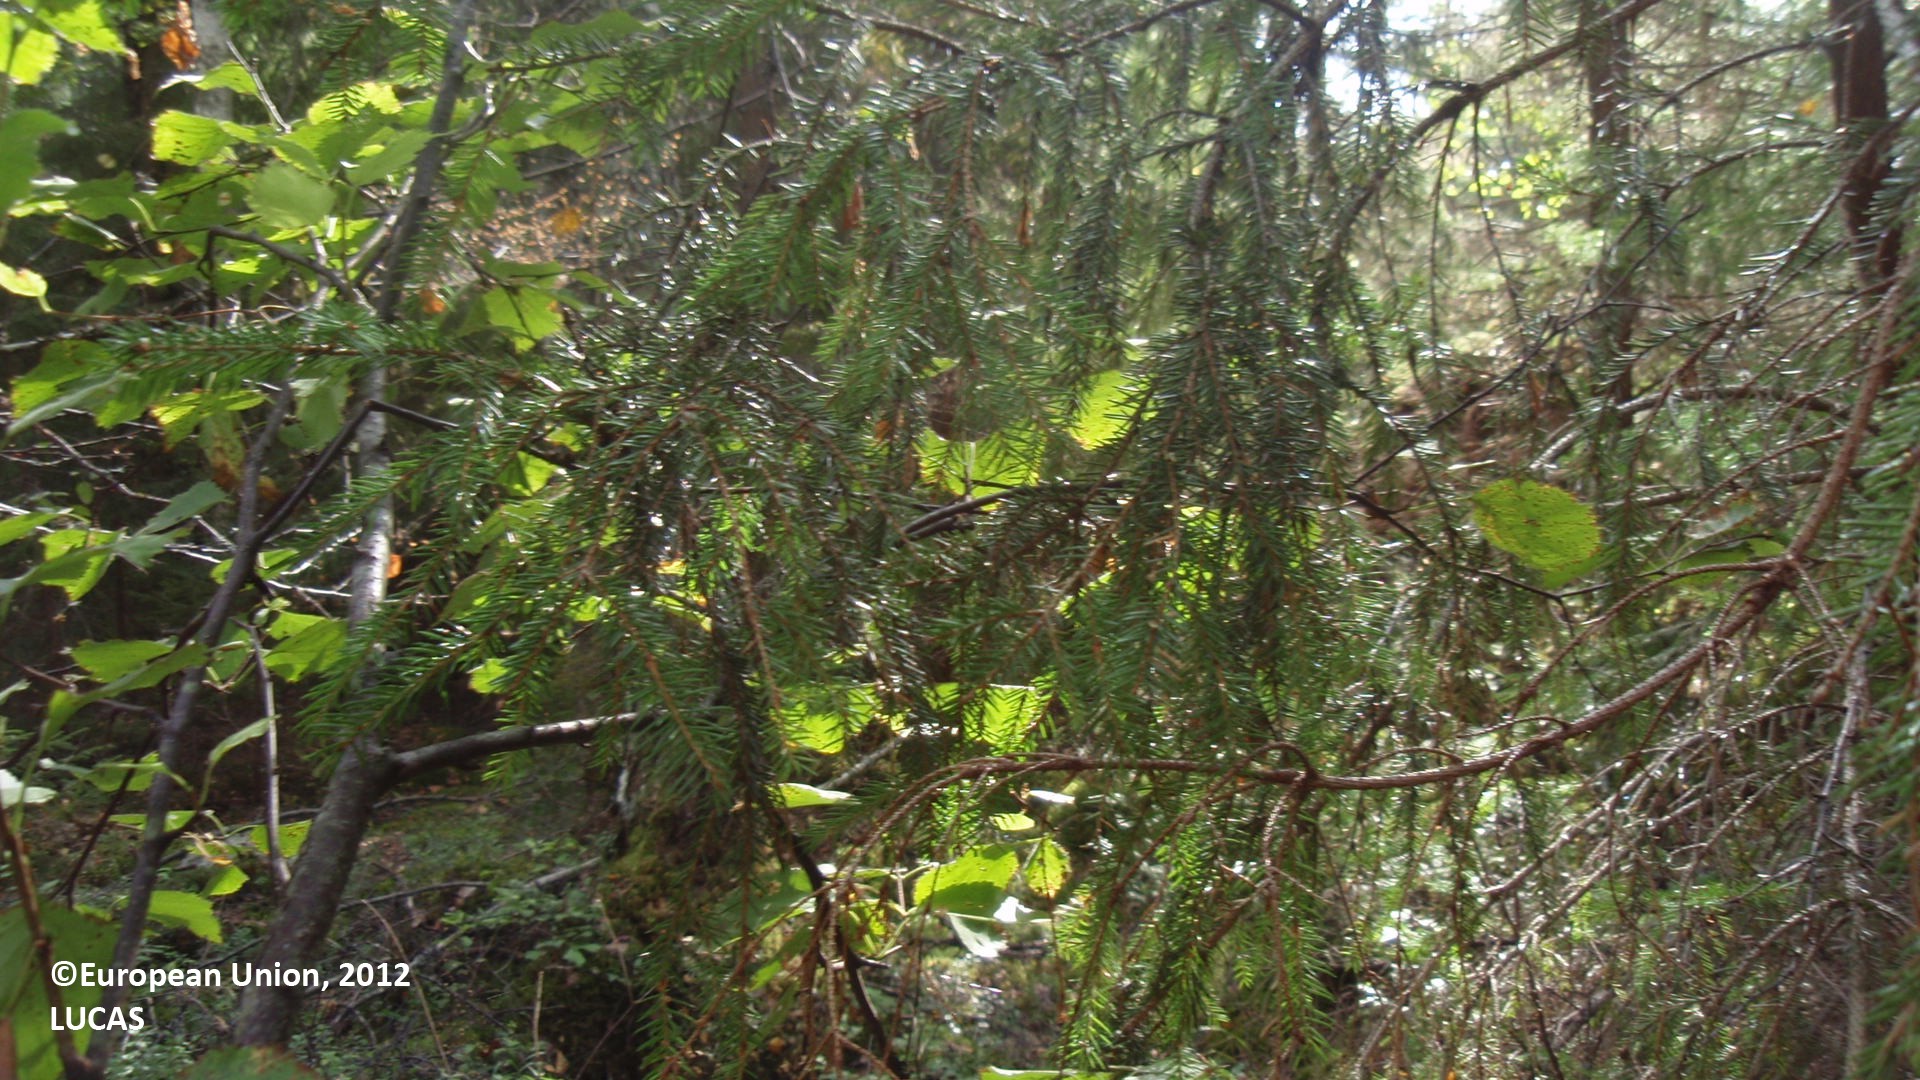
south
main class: Woodland
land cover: Spruce dominated mixed woodland
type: boreal forest
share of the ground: 50 - 75 %
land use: Forestry
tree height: > 5 m
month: August
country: FI
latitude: 60.8073
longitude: 27.2507
